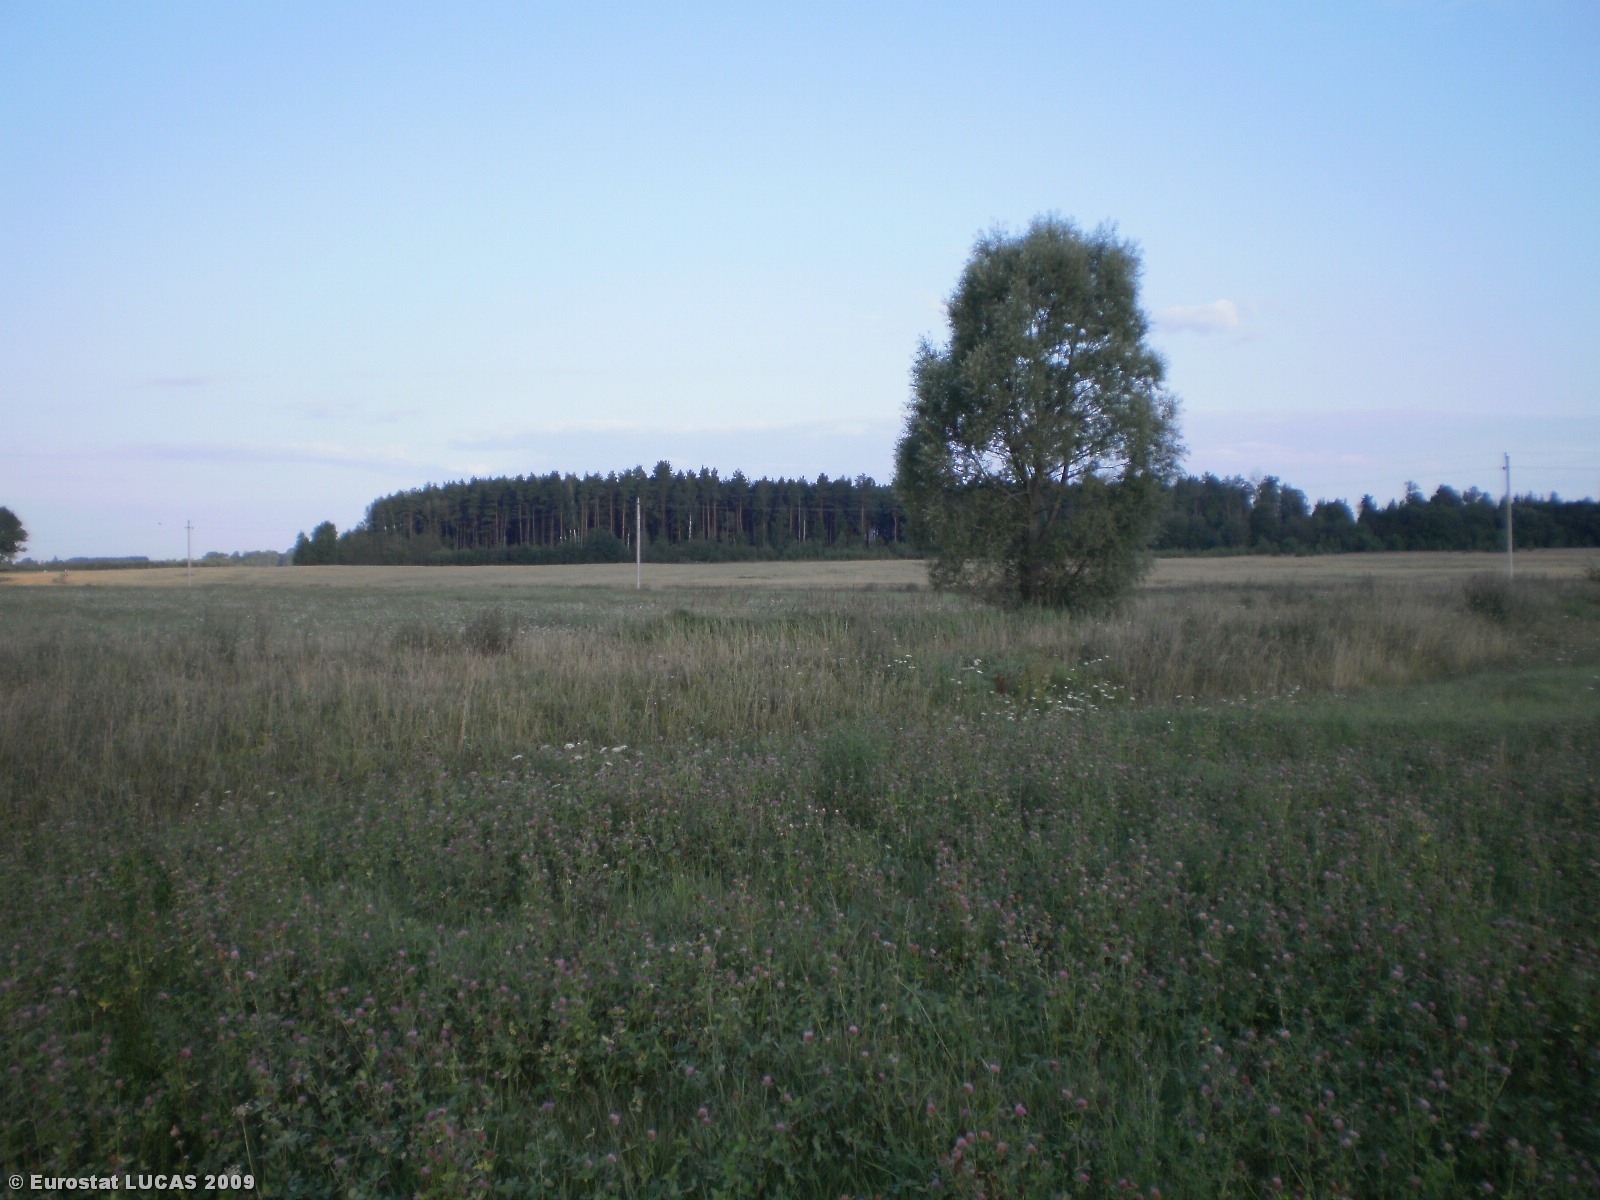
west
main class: Cropland
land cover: Clovers
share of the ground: > 75 %
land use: Agriculture (excluding fallow land and kitchen gardens)
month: August
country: LT
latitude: 55.5252
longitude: 24.7912
